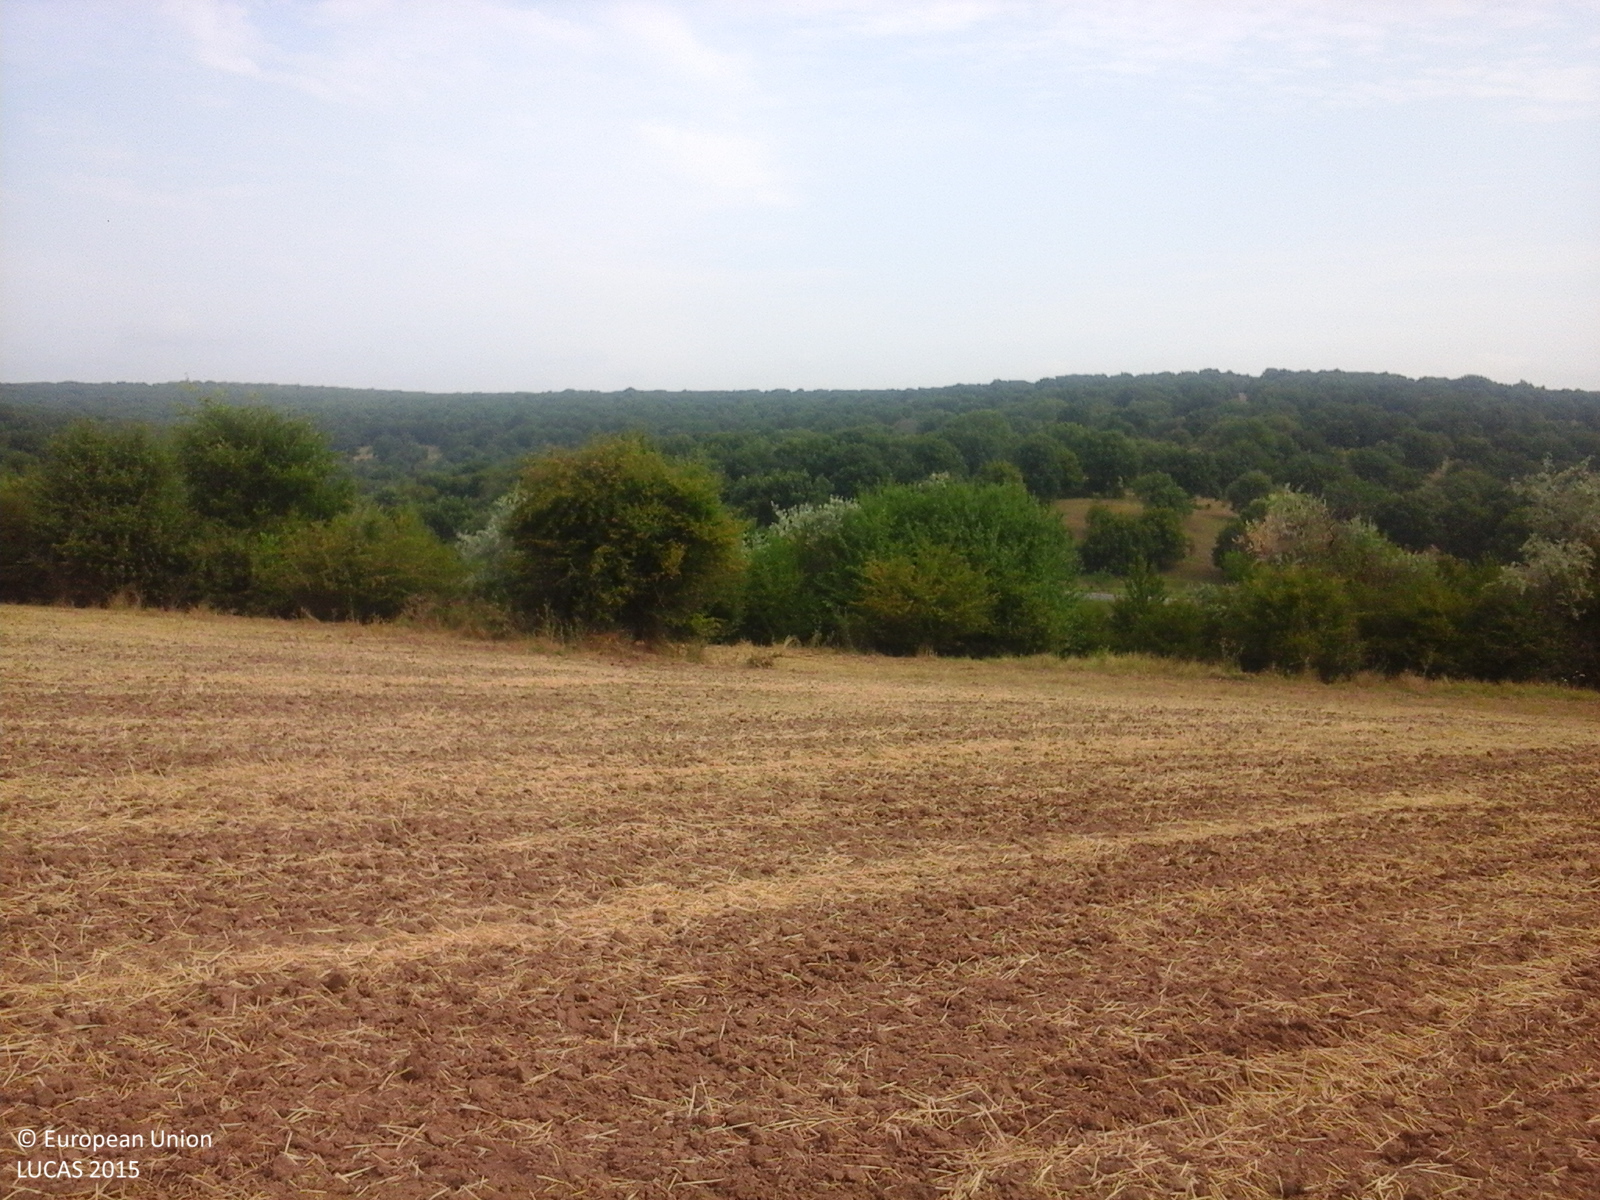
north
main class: Cropland
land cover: Durum wheat
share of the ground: < 10 %
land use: Agriculture (excluding fallow land and kitchen gardens)
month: July
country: RO
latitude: 44.9857
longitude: 28.4537
